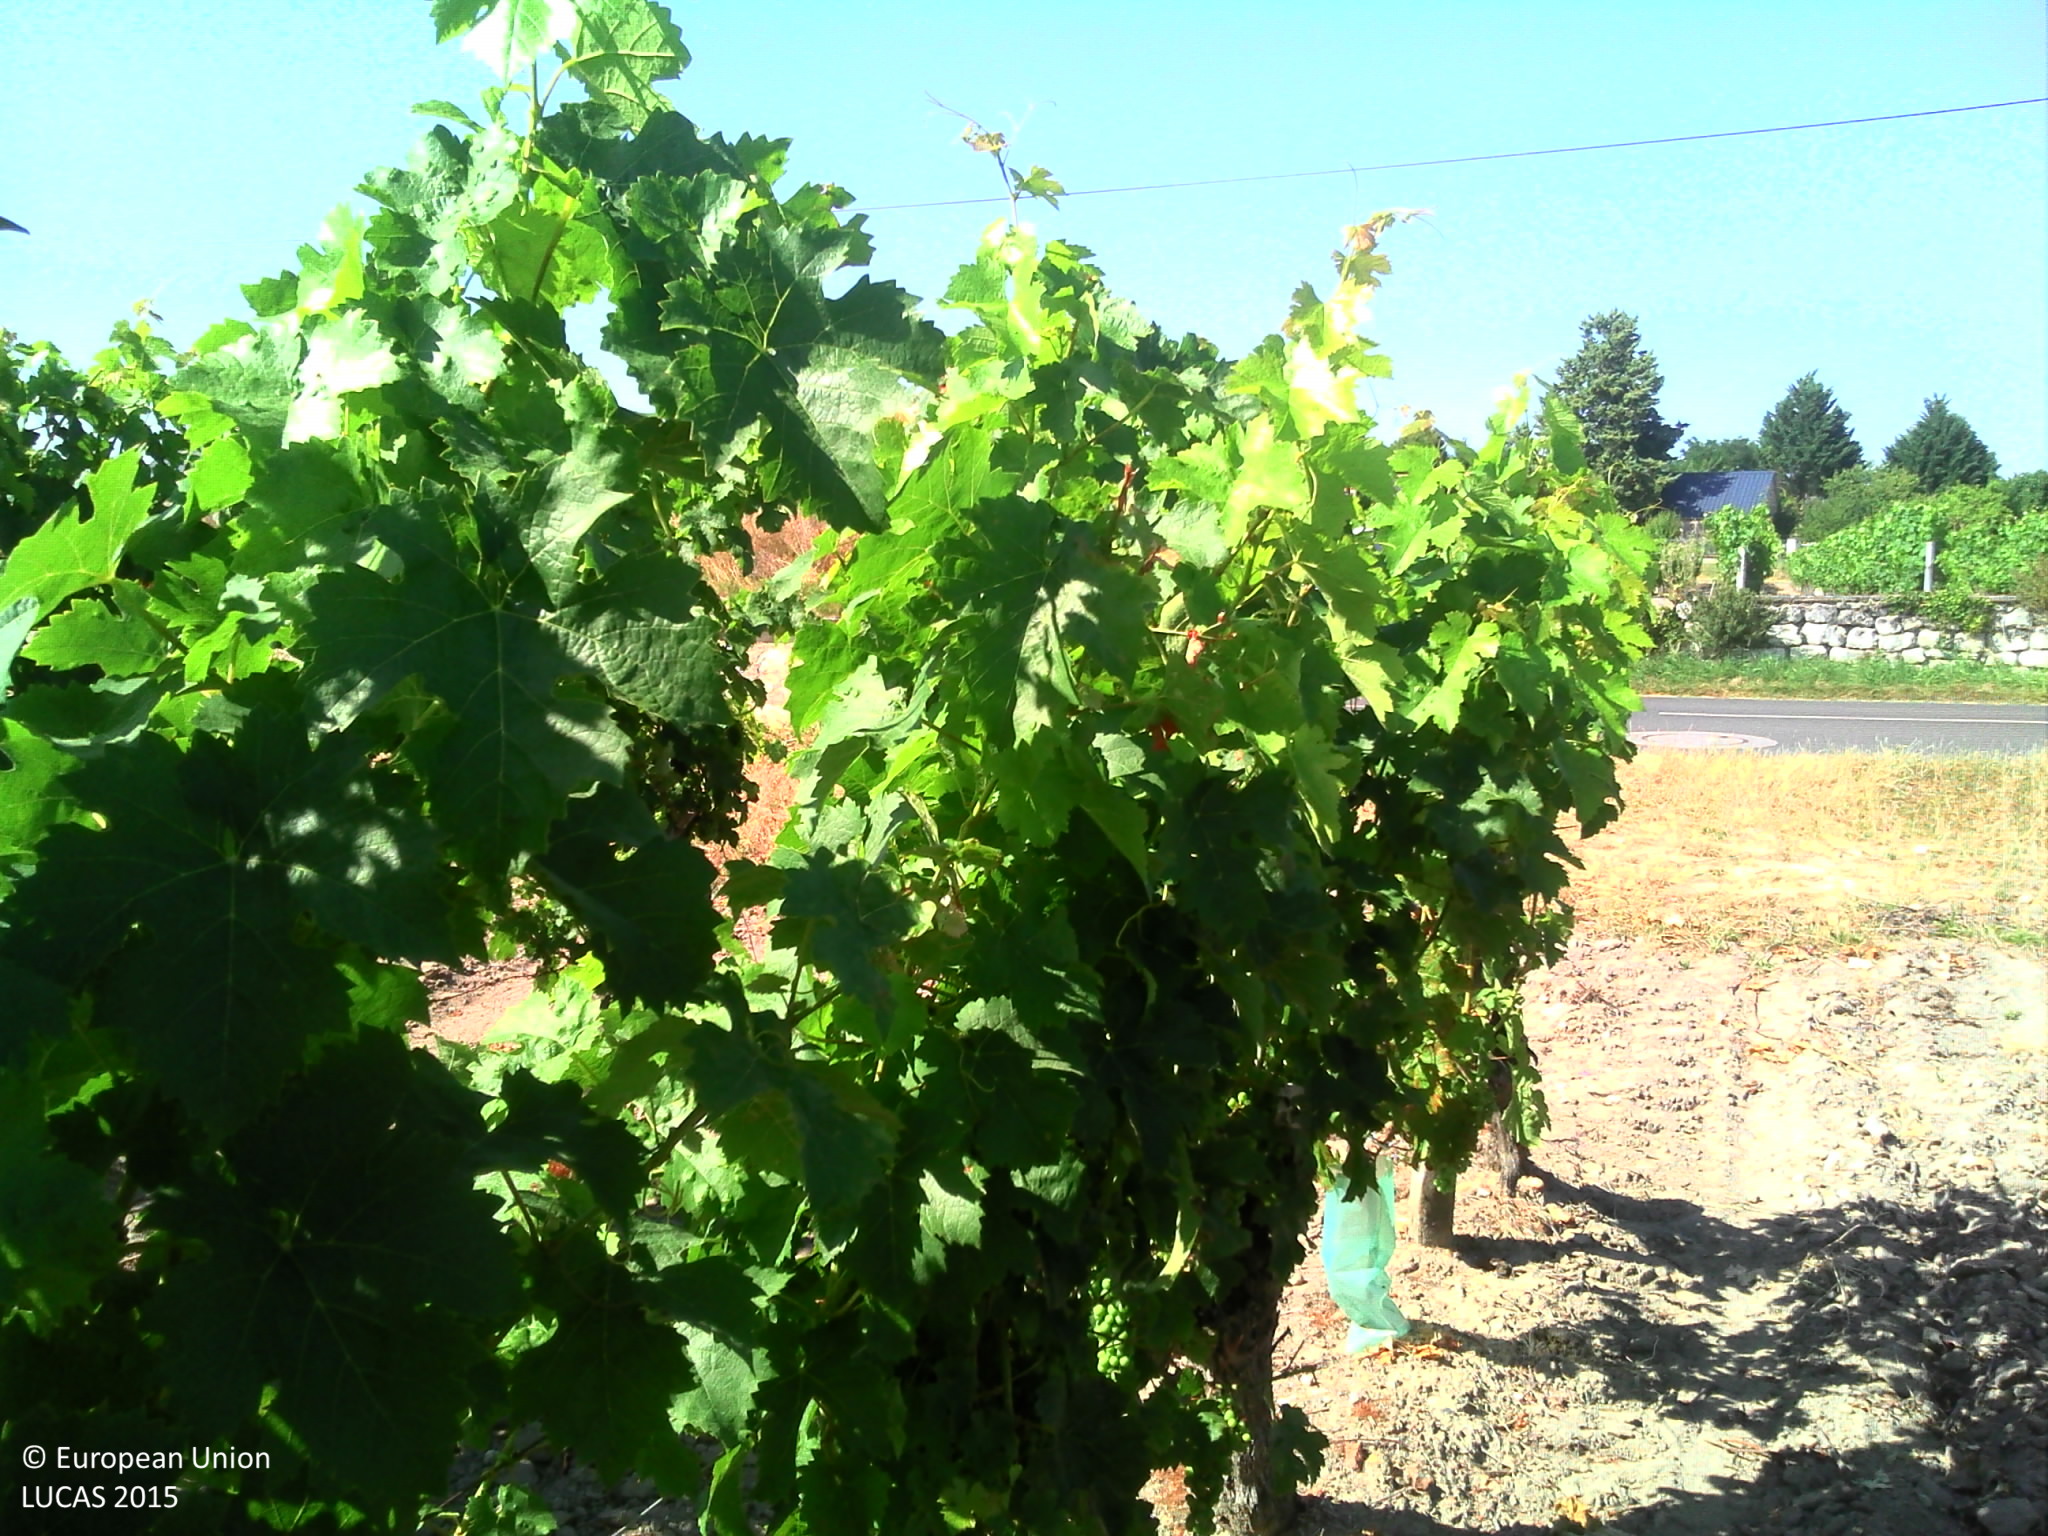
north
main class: Cropland
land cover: Vineyards
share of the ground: 50 - 75 %
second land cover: Other bare soil
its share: > 75 %
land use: Agriculture (excluding fallow land and kitchen gardens)
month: July
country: FR
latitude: 47.1851
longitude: 0.1718
